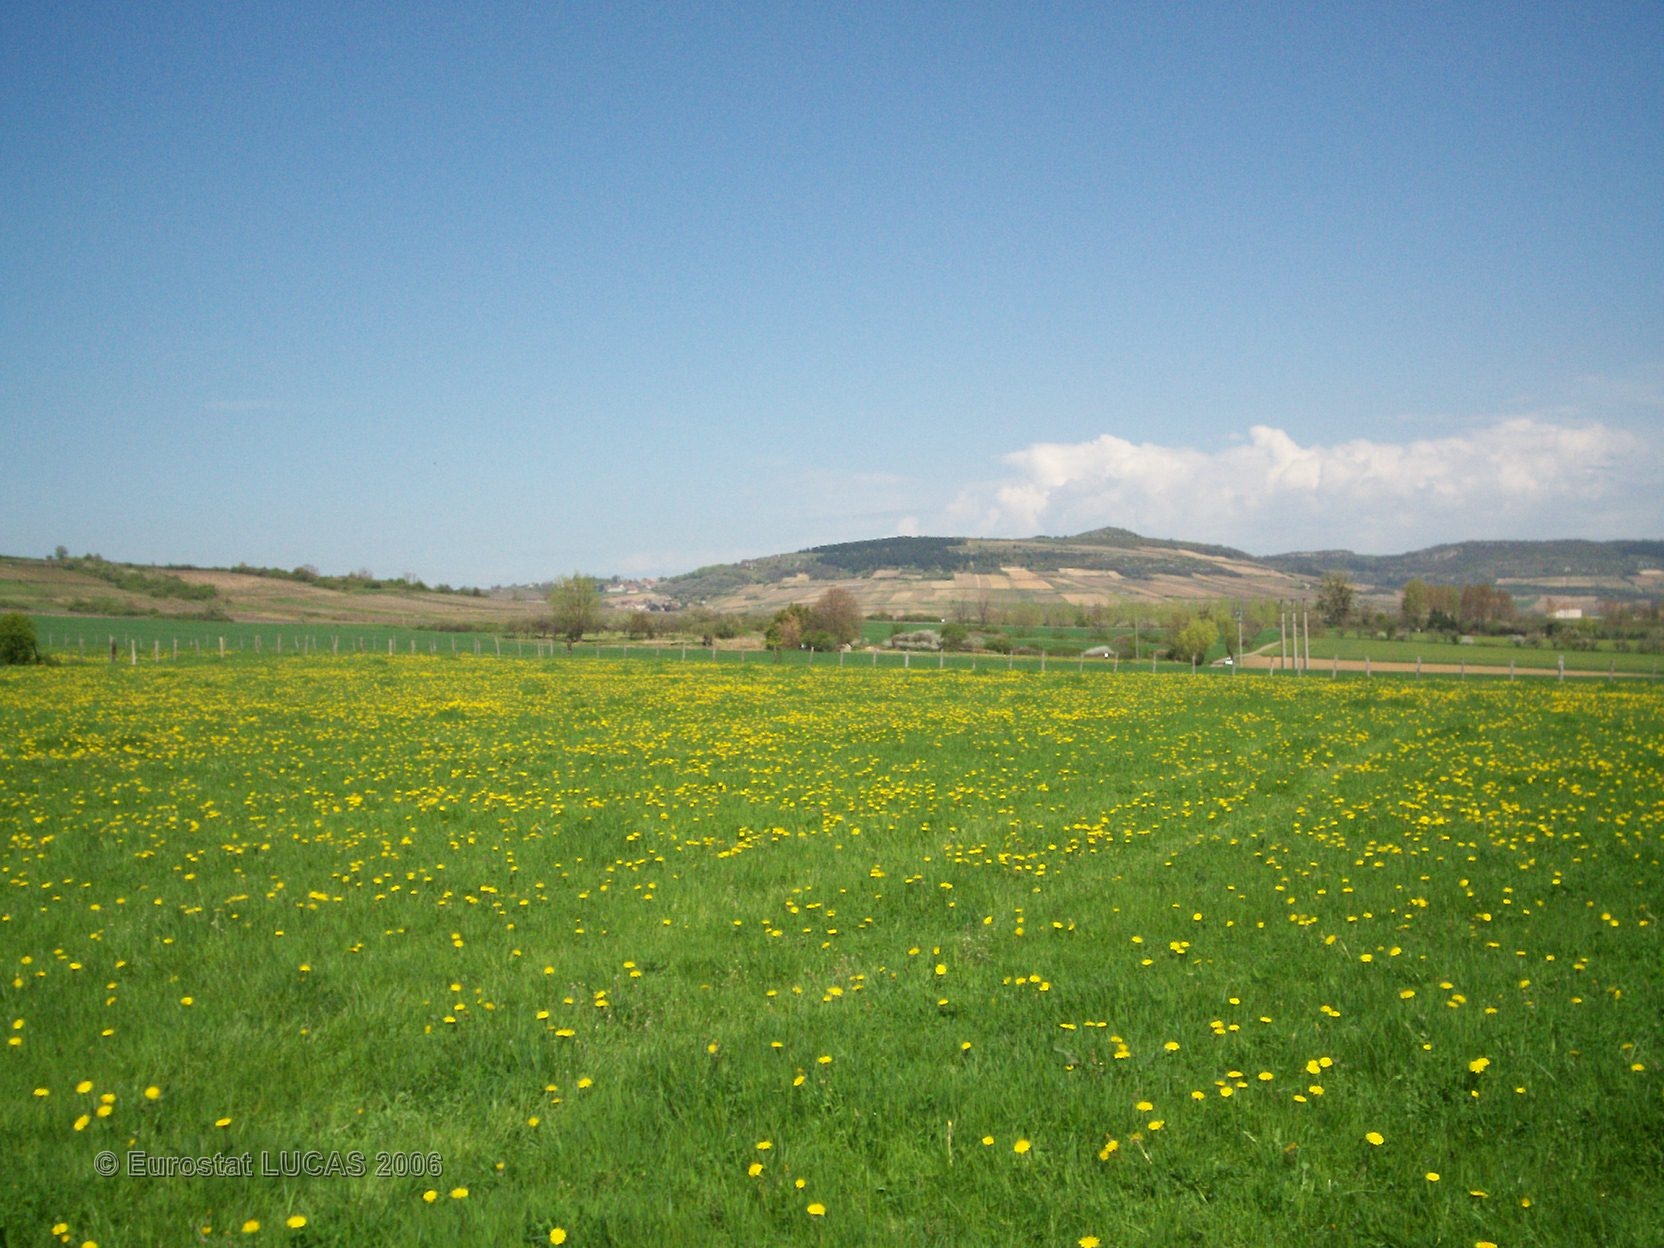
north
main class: Grassland
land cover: Grassland without tree/shrub cover
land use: Agriculture (excluding fallow land and kitchen gardens)
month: April
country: FR
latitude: 46.8856
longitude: 4.6596
